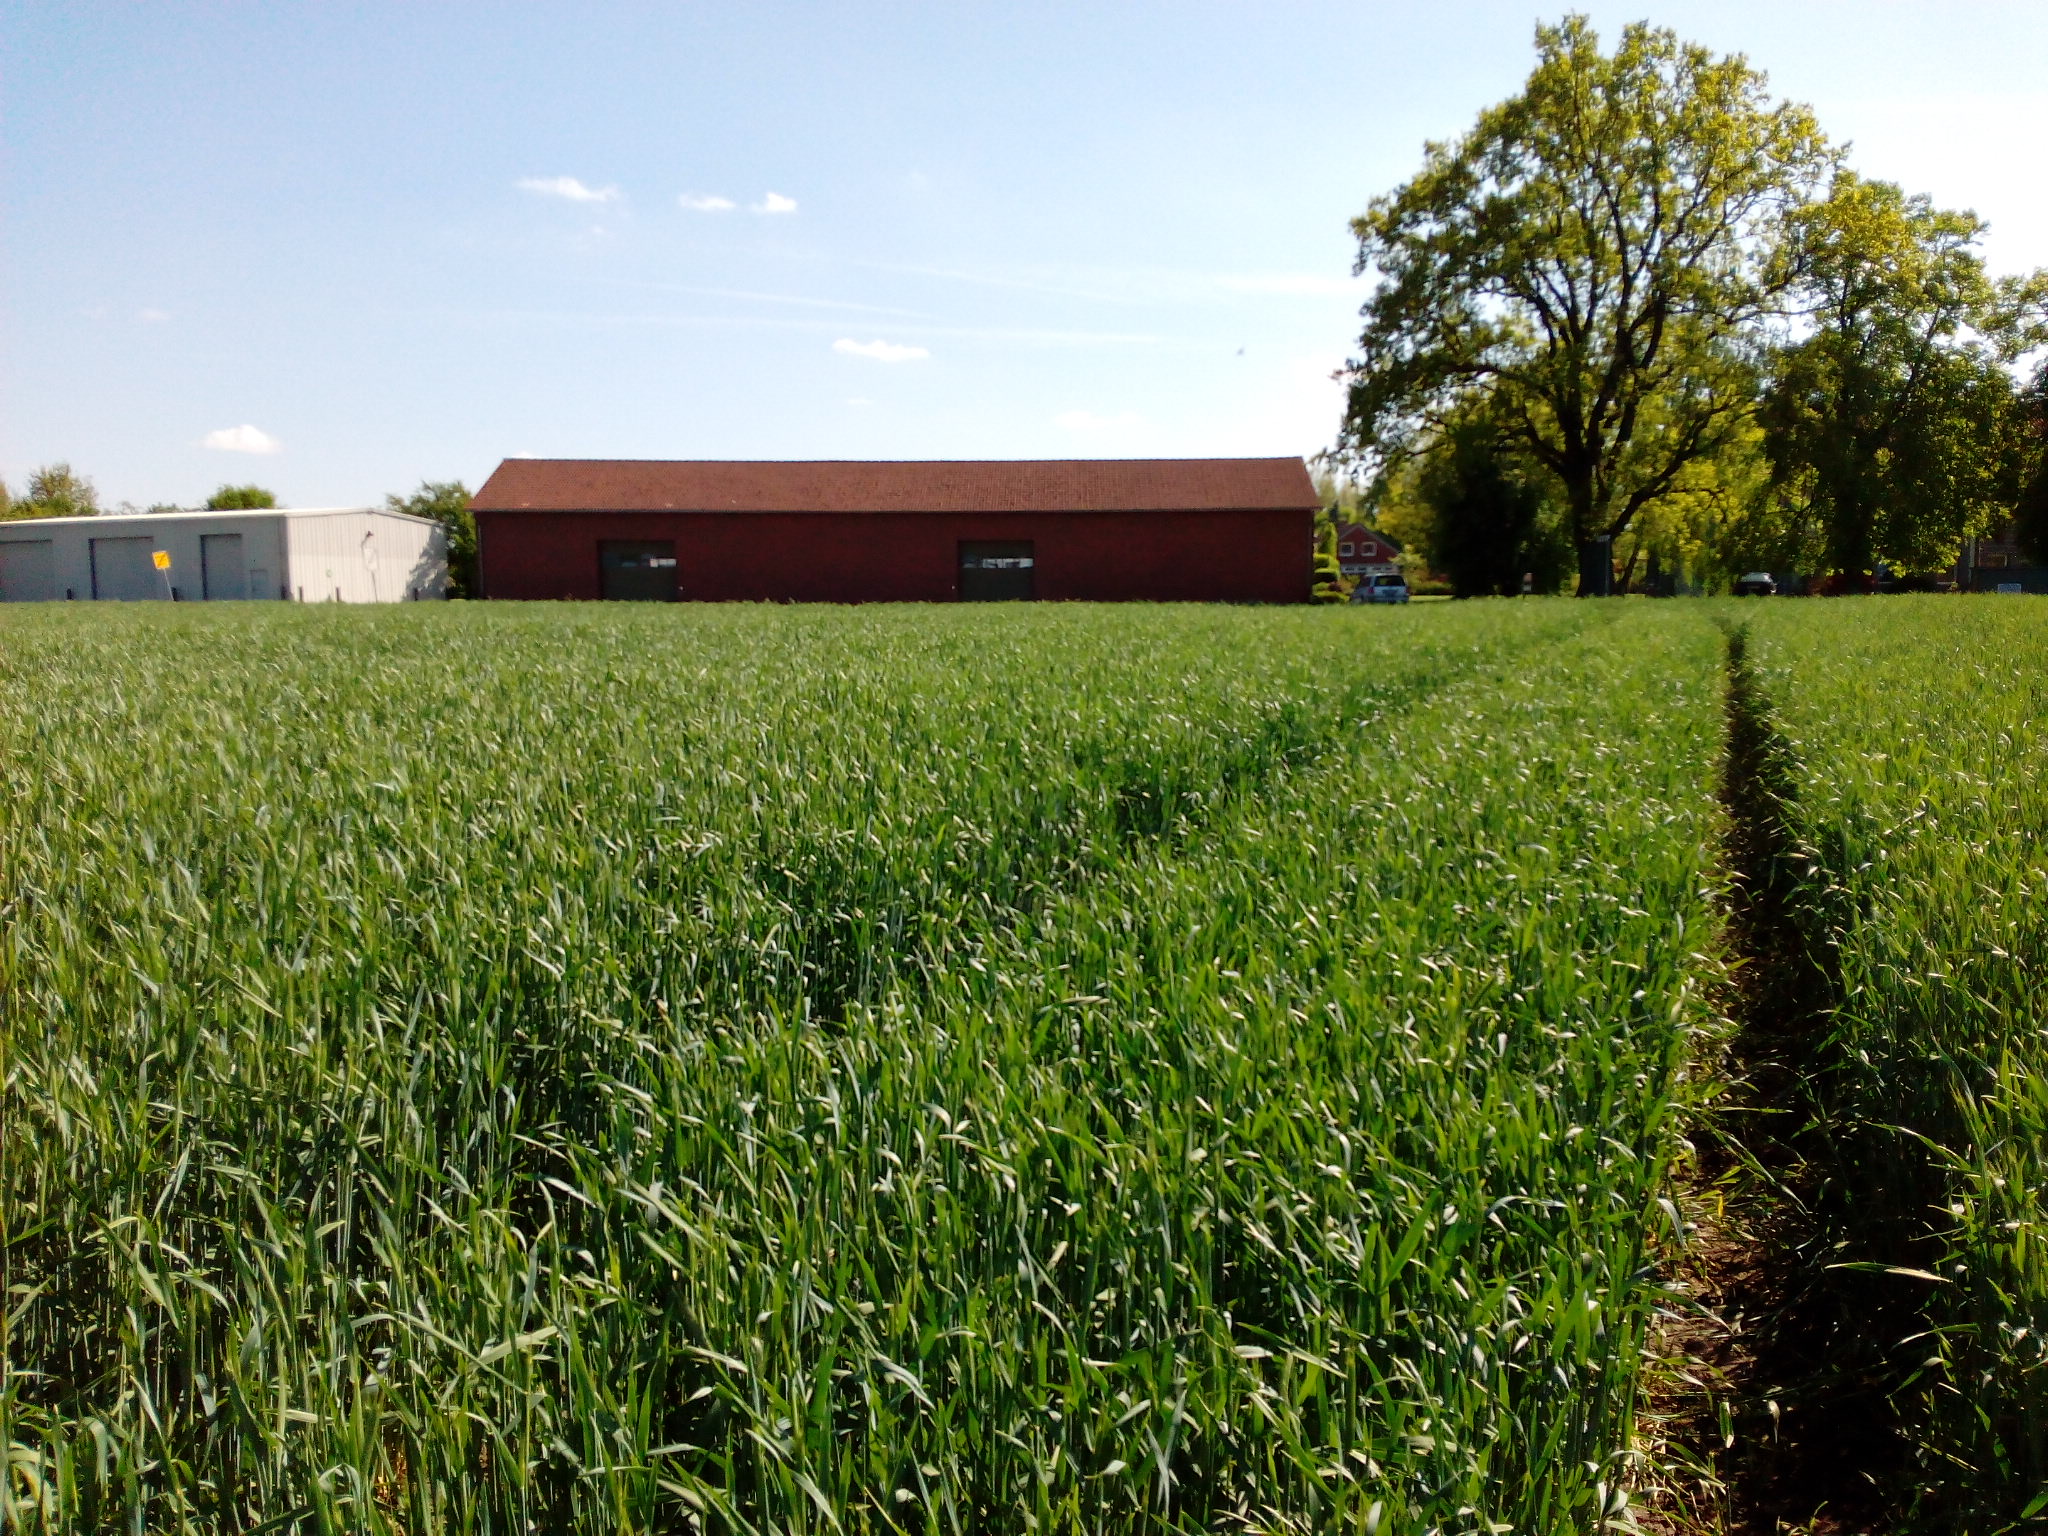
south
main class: Cropland
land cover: Rye
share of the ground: > 75 %
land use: Agriculture (excluding fallow land and kitchen gardens)
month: May
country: DE
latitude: 52.4852
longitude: 9.8675
